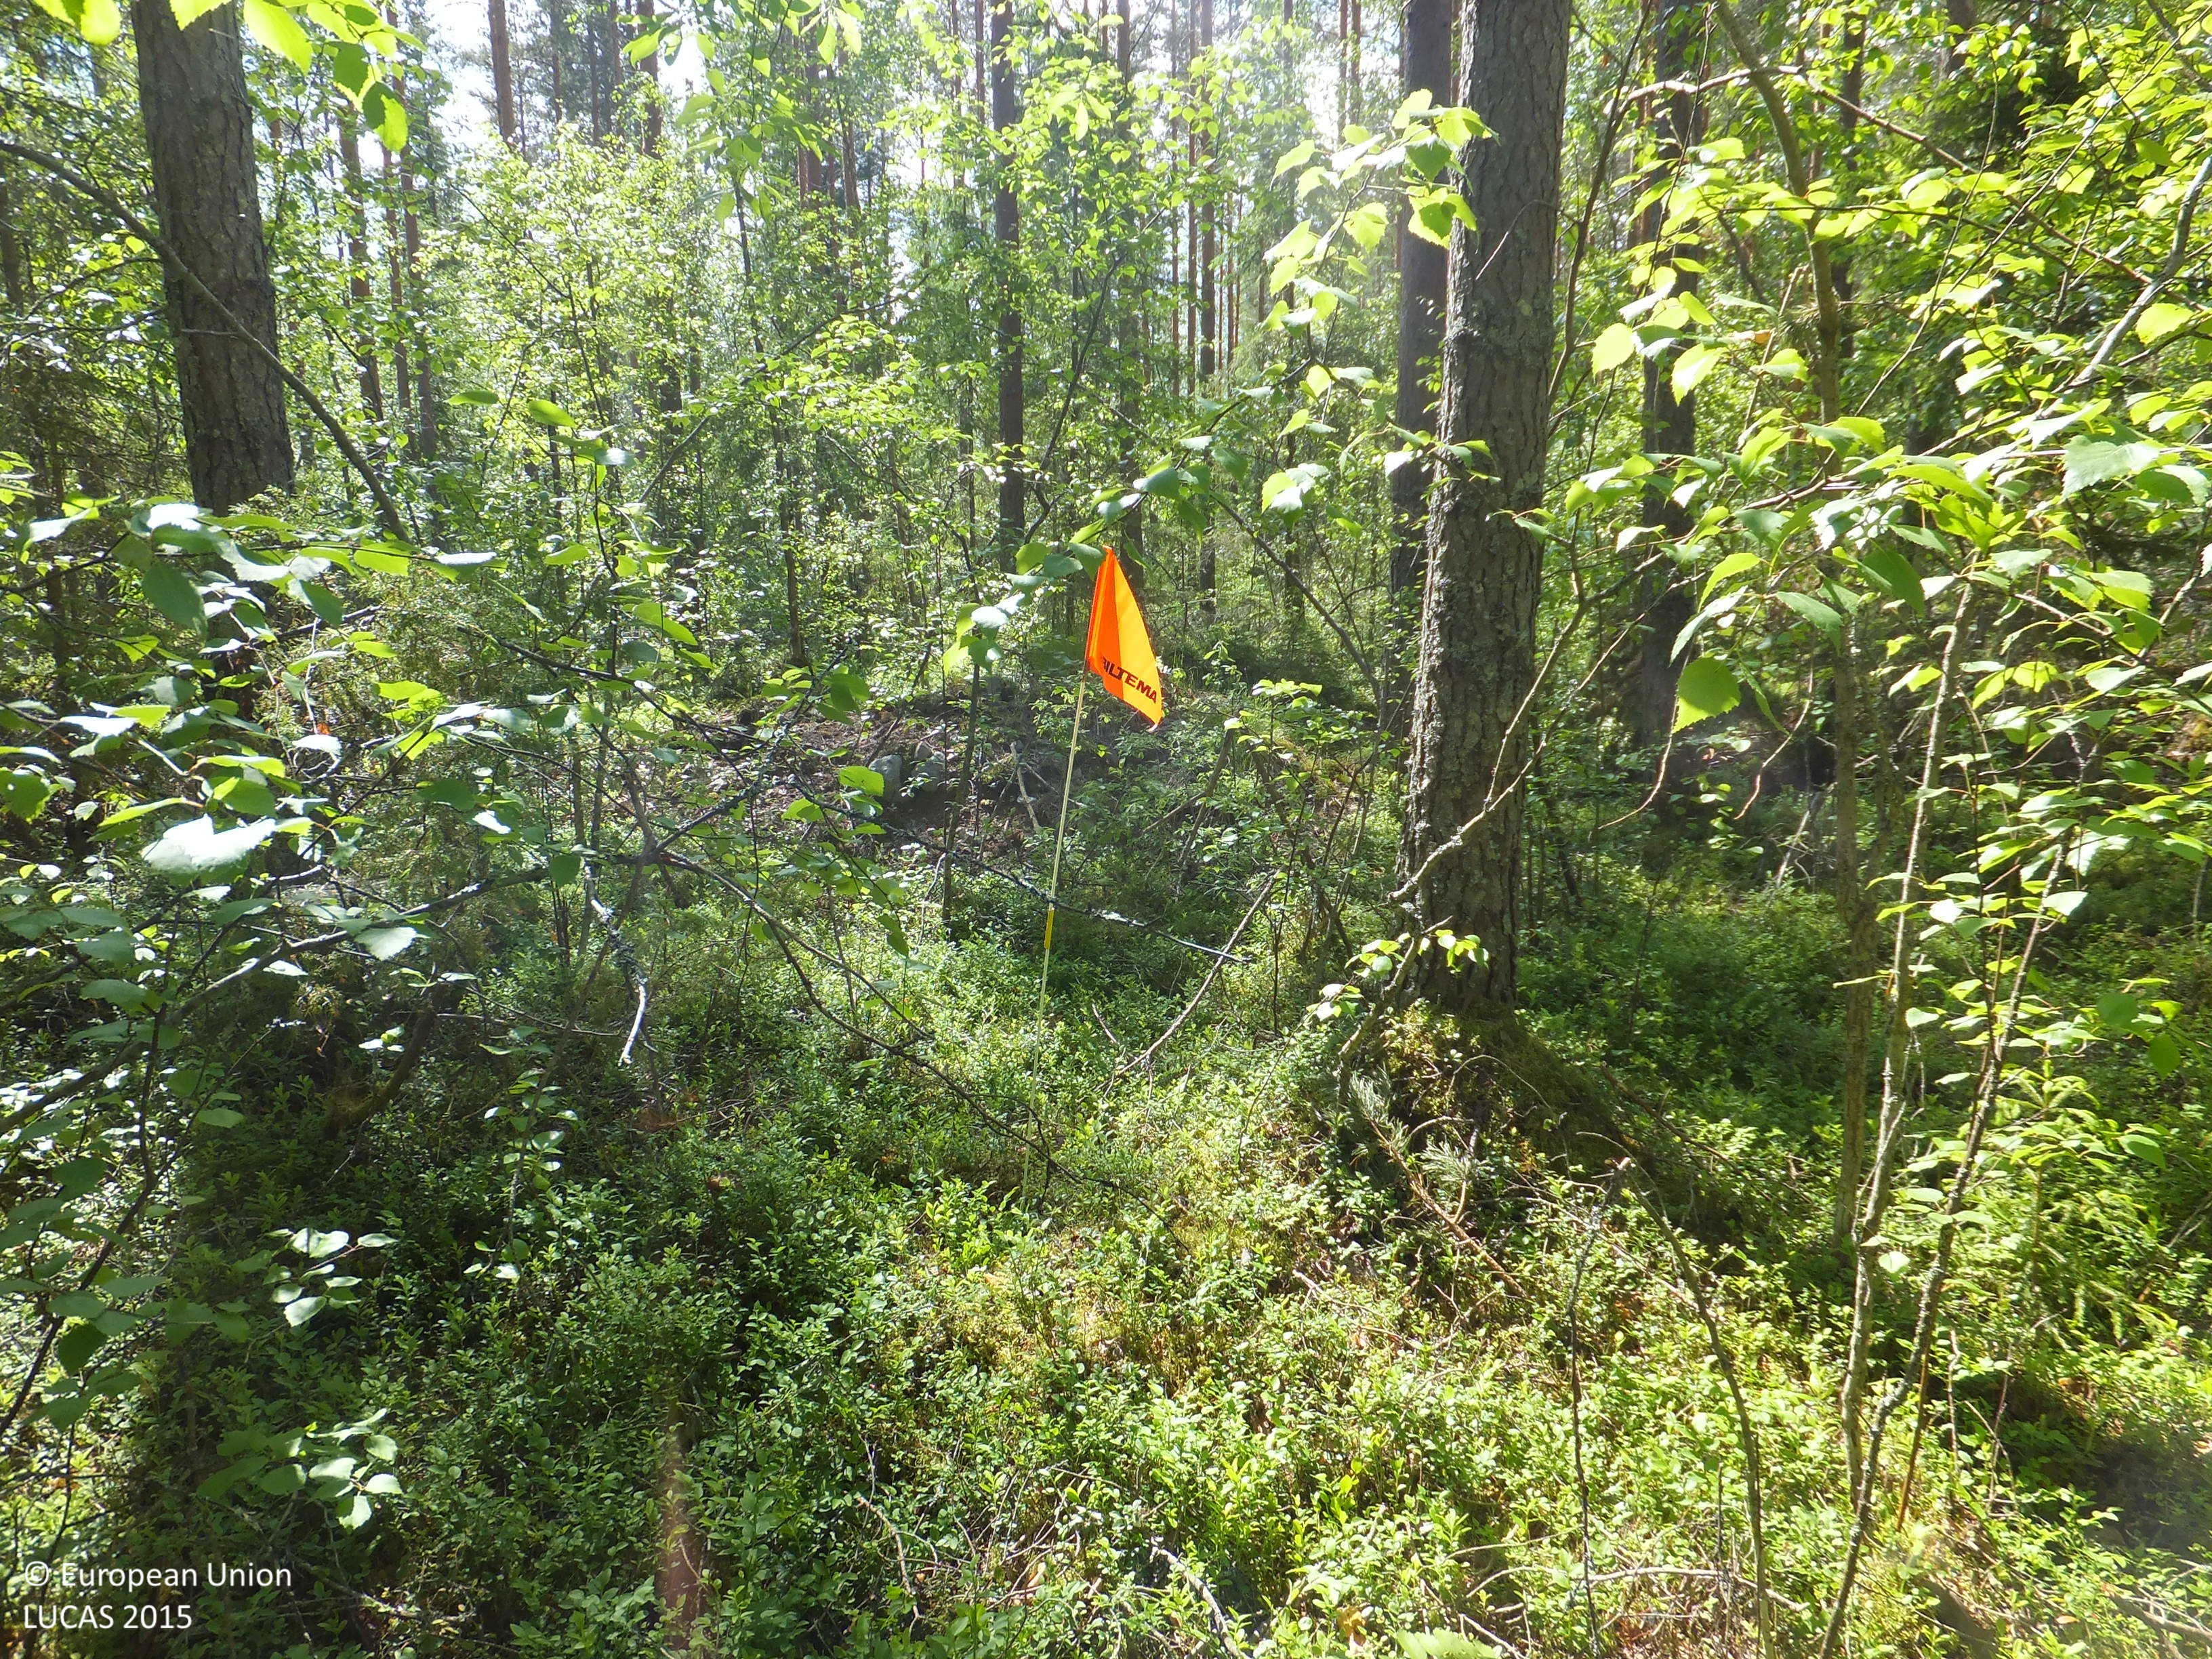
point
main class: Woodland
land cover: Pine dominated mixed woodland
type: boreal forest
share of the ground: 50 - 75 %
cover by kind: coniferous forest trees 35 %, broadleaved forest trees 25 %, shrubs 20 %, herbaceous plants 10 %, lichens and mosses 10 %
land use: Forestry
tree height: > 5 m
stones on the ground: 25 - 50 %
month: June
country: FI
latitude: 63.2024
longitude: 24.0105
